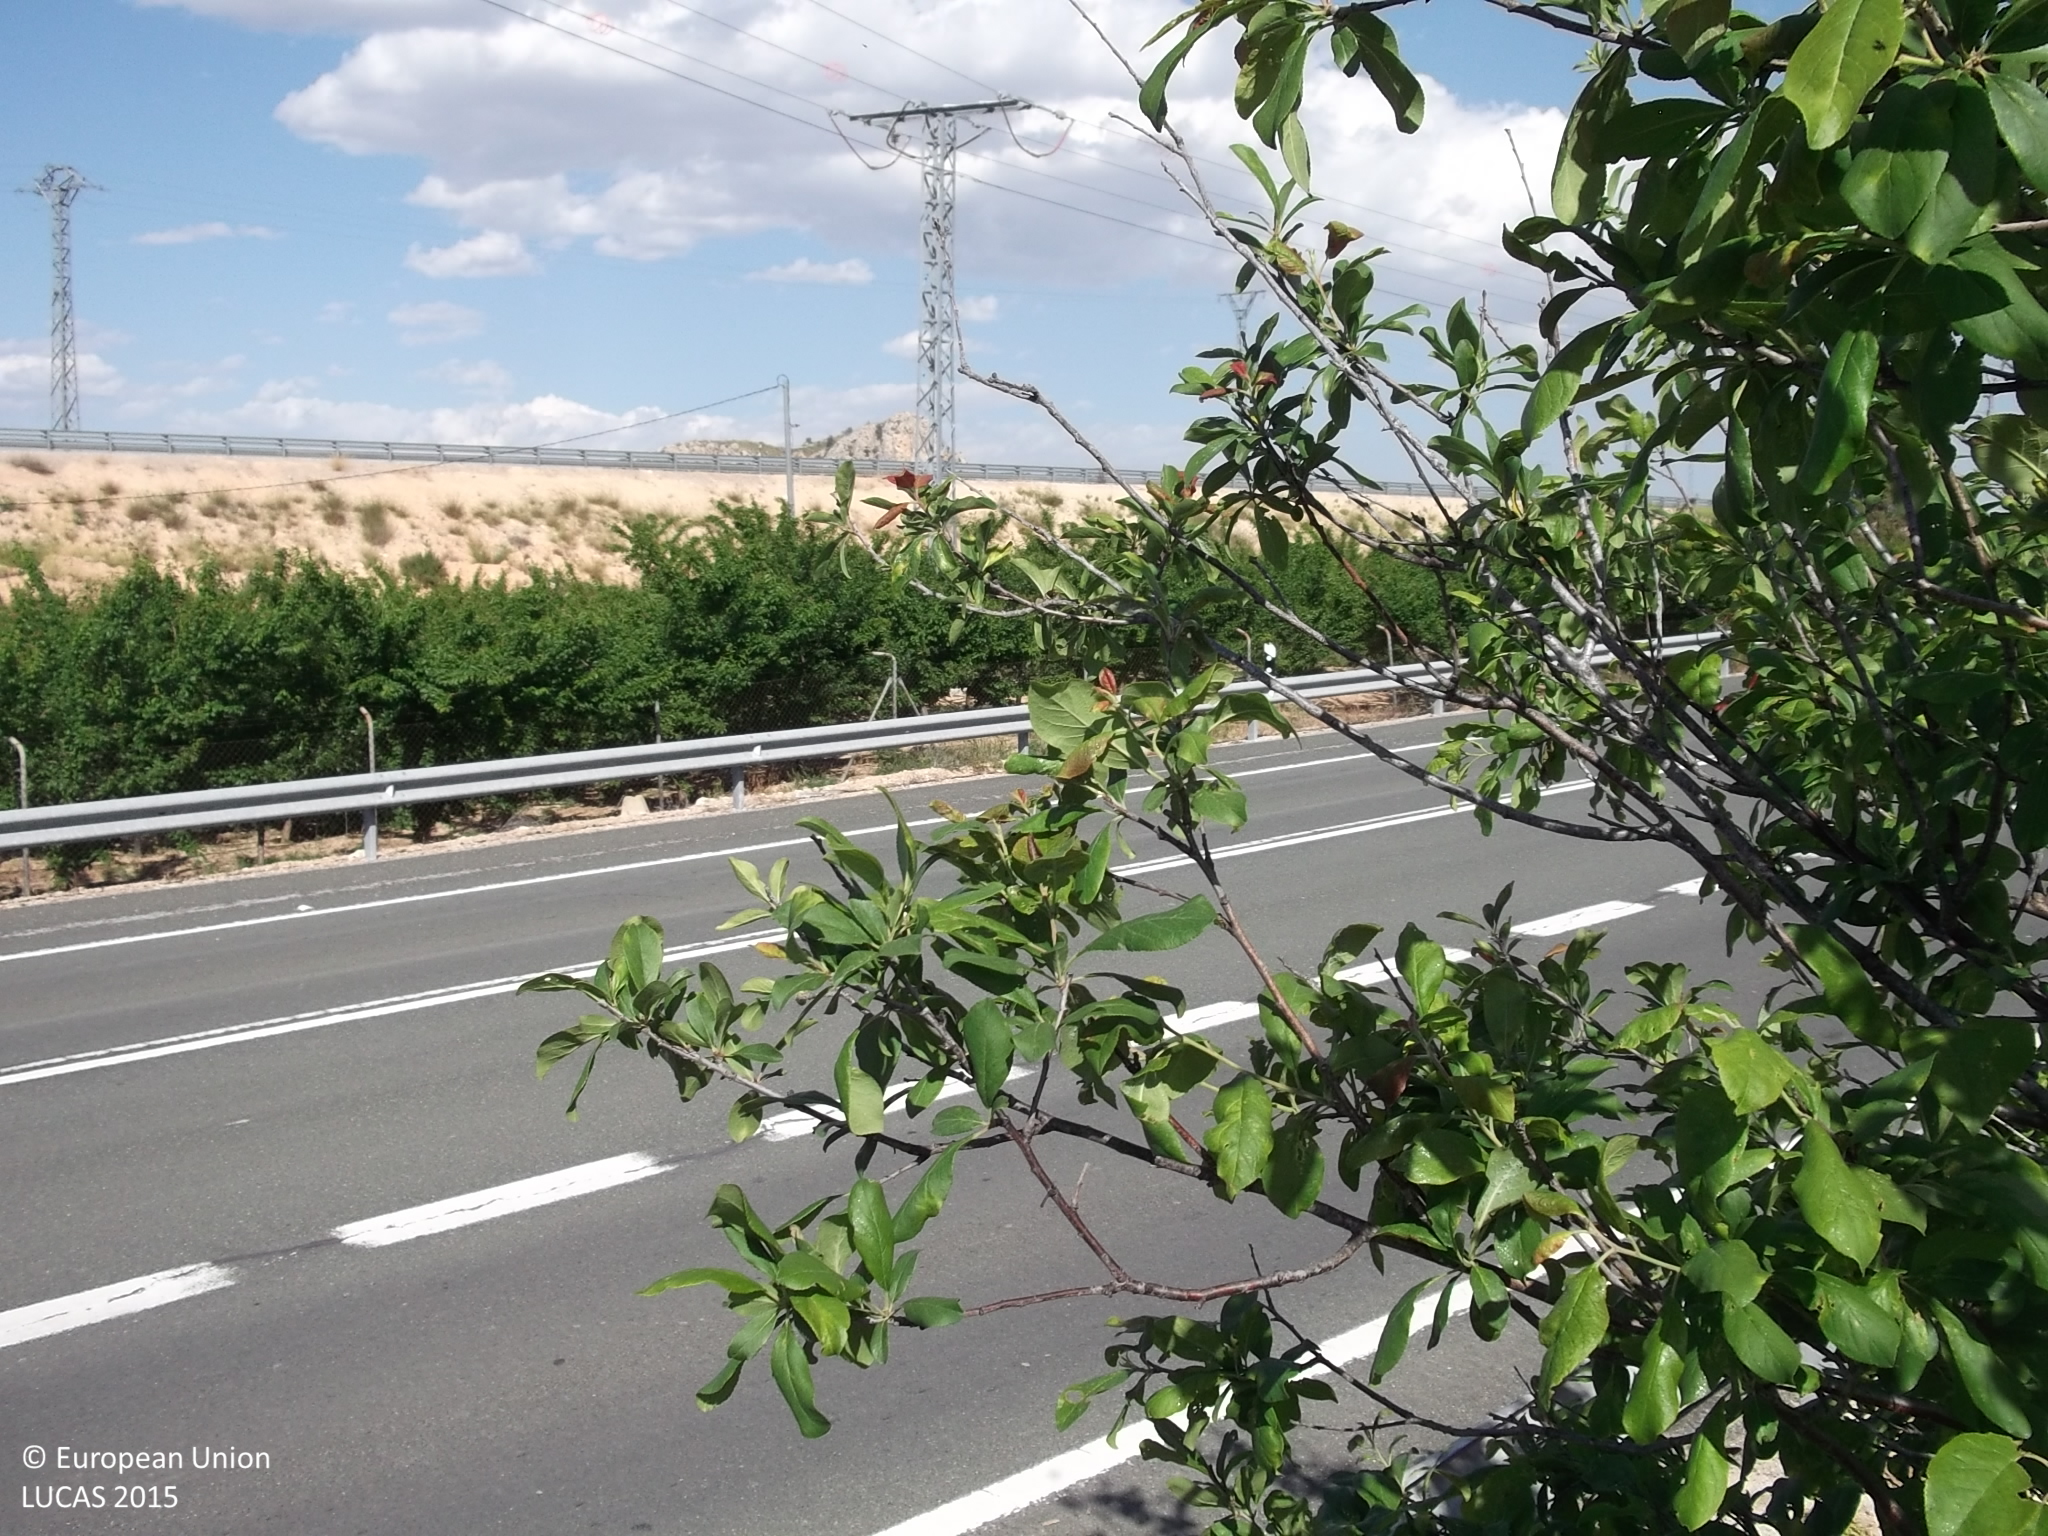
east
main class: Cropland
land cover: Other citrus fruit
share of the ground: 25 - 50 %
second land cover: Spontaneously vegetated surfaces
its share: > 75 %
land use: Agriculture (excluding fallow land and kitchen gardens)
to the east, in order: Other citrus fruit; Spontaneously vegetated surfaces; Fences; Grass margins; Paved roads, cycling and walking lanes; Grass margins; Fences; Other fruit trees and berries; Fences; Spontaneously vegetated surfaces; Fences; Paved roads, cycling and walking lanes; Shrubland without tree cover; Paved roads, cycling and walking lanes; Shrubland without tree cover; Paved roads, cycling and walking lanes
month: April
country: ES
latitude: 38.1846
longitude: -1.3240
